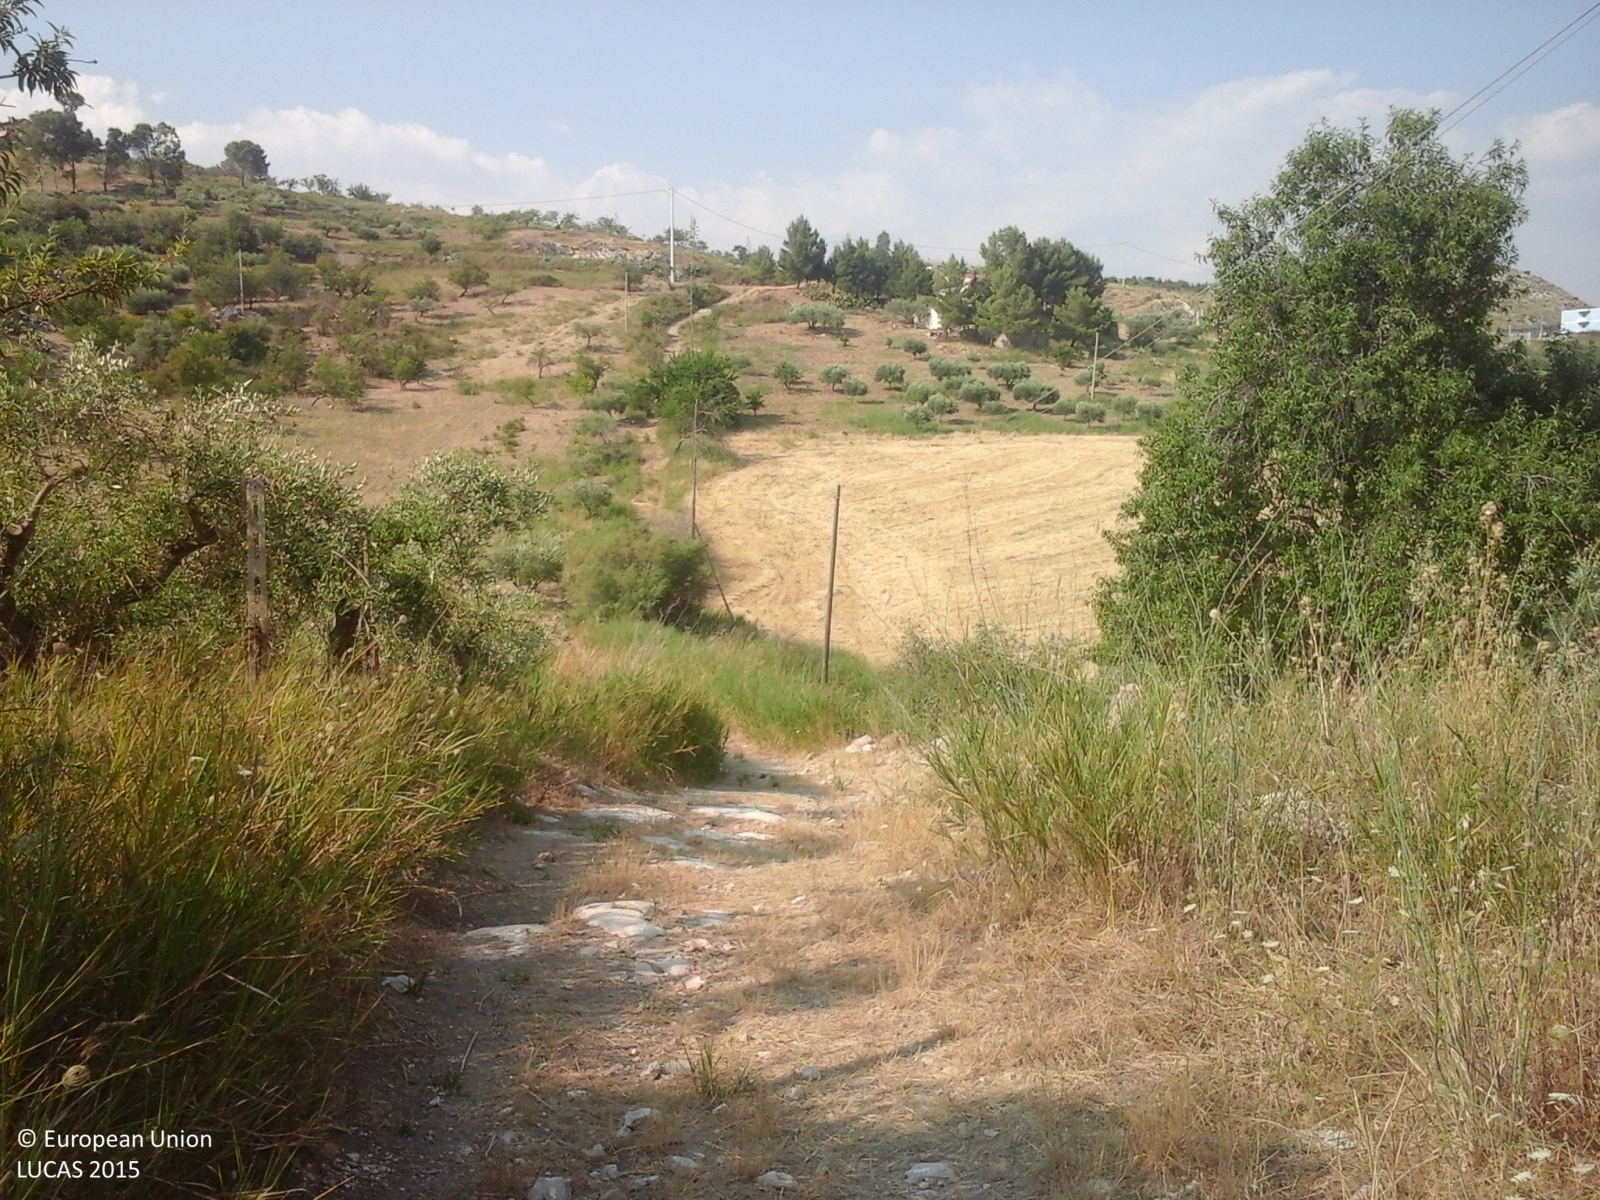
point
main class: Cropland
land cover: Durum wheat
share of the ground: > 75 %
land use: Agriculture (excluding fallow land and kitchen gardens)
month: July
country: IT
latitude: 37.4630
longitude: 13.5568
